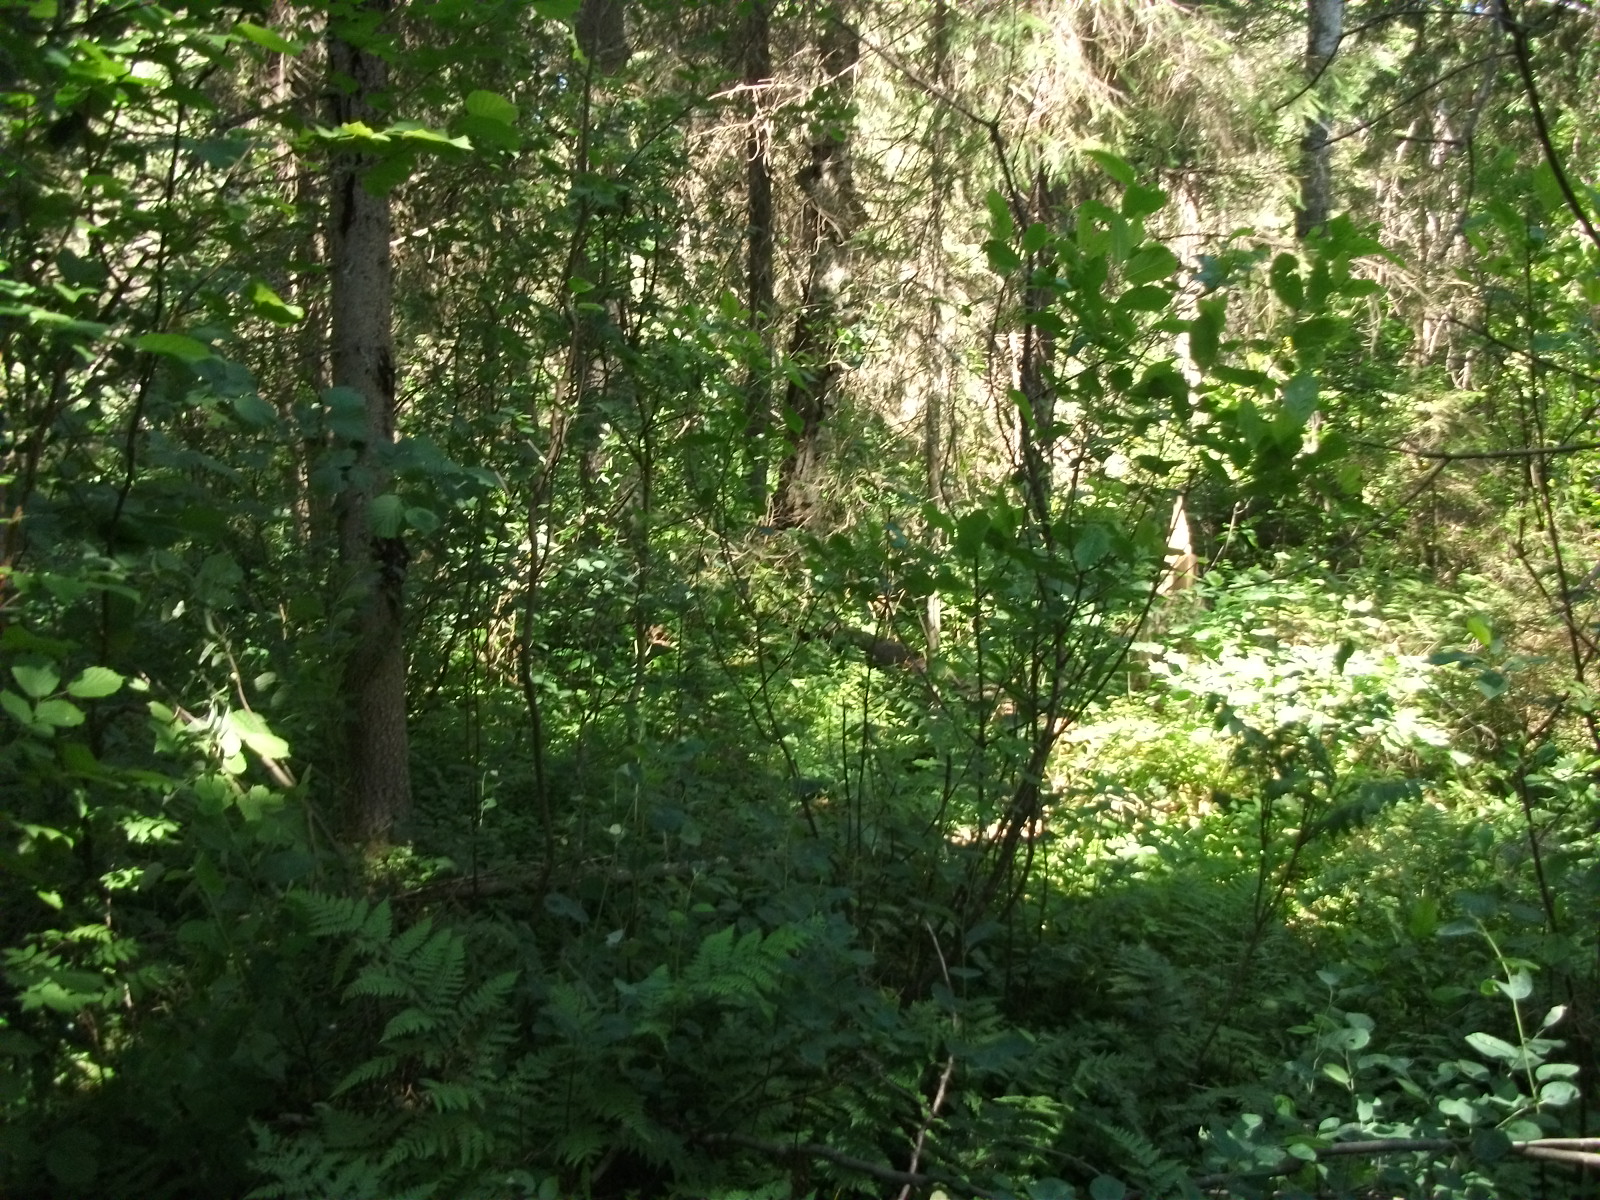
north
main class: Woodland
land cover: Spruce dominated coniferous woodland
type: hemiboreal forest and nemoral coniferous forest and mixed broadleaved-coniferous forest
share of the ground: > 75 %
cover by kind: coniferous forest trees 75 %, broadleaved forest trees 10 %, shrubs 10 %, herbaceous plants 5 %
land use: Forestry
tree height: > 5 m
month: July
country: LV
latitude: 56.7545
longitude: 26.1481
